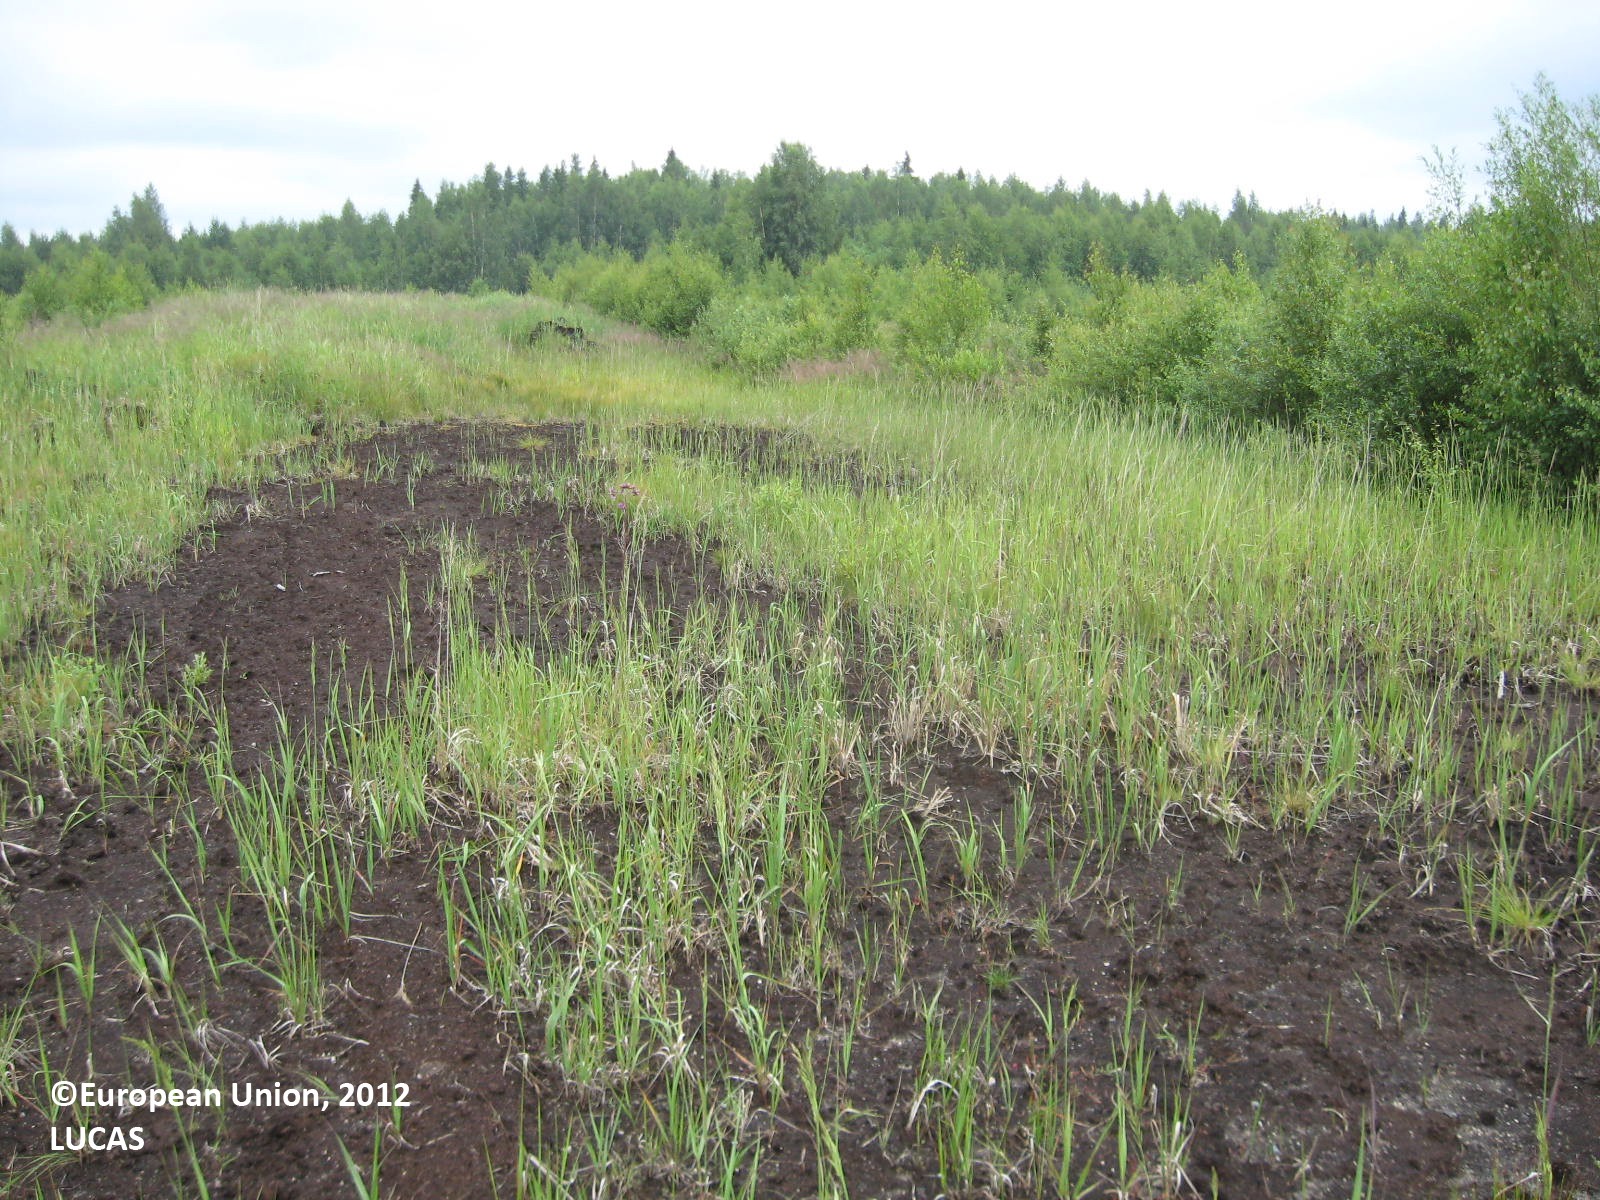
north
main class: Grassland
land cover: Spontaneously vegetated surfaces
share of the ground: > 75 %
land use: Abandoned areas
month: July
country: FI
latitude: 62.4679
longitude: 22.5646
